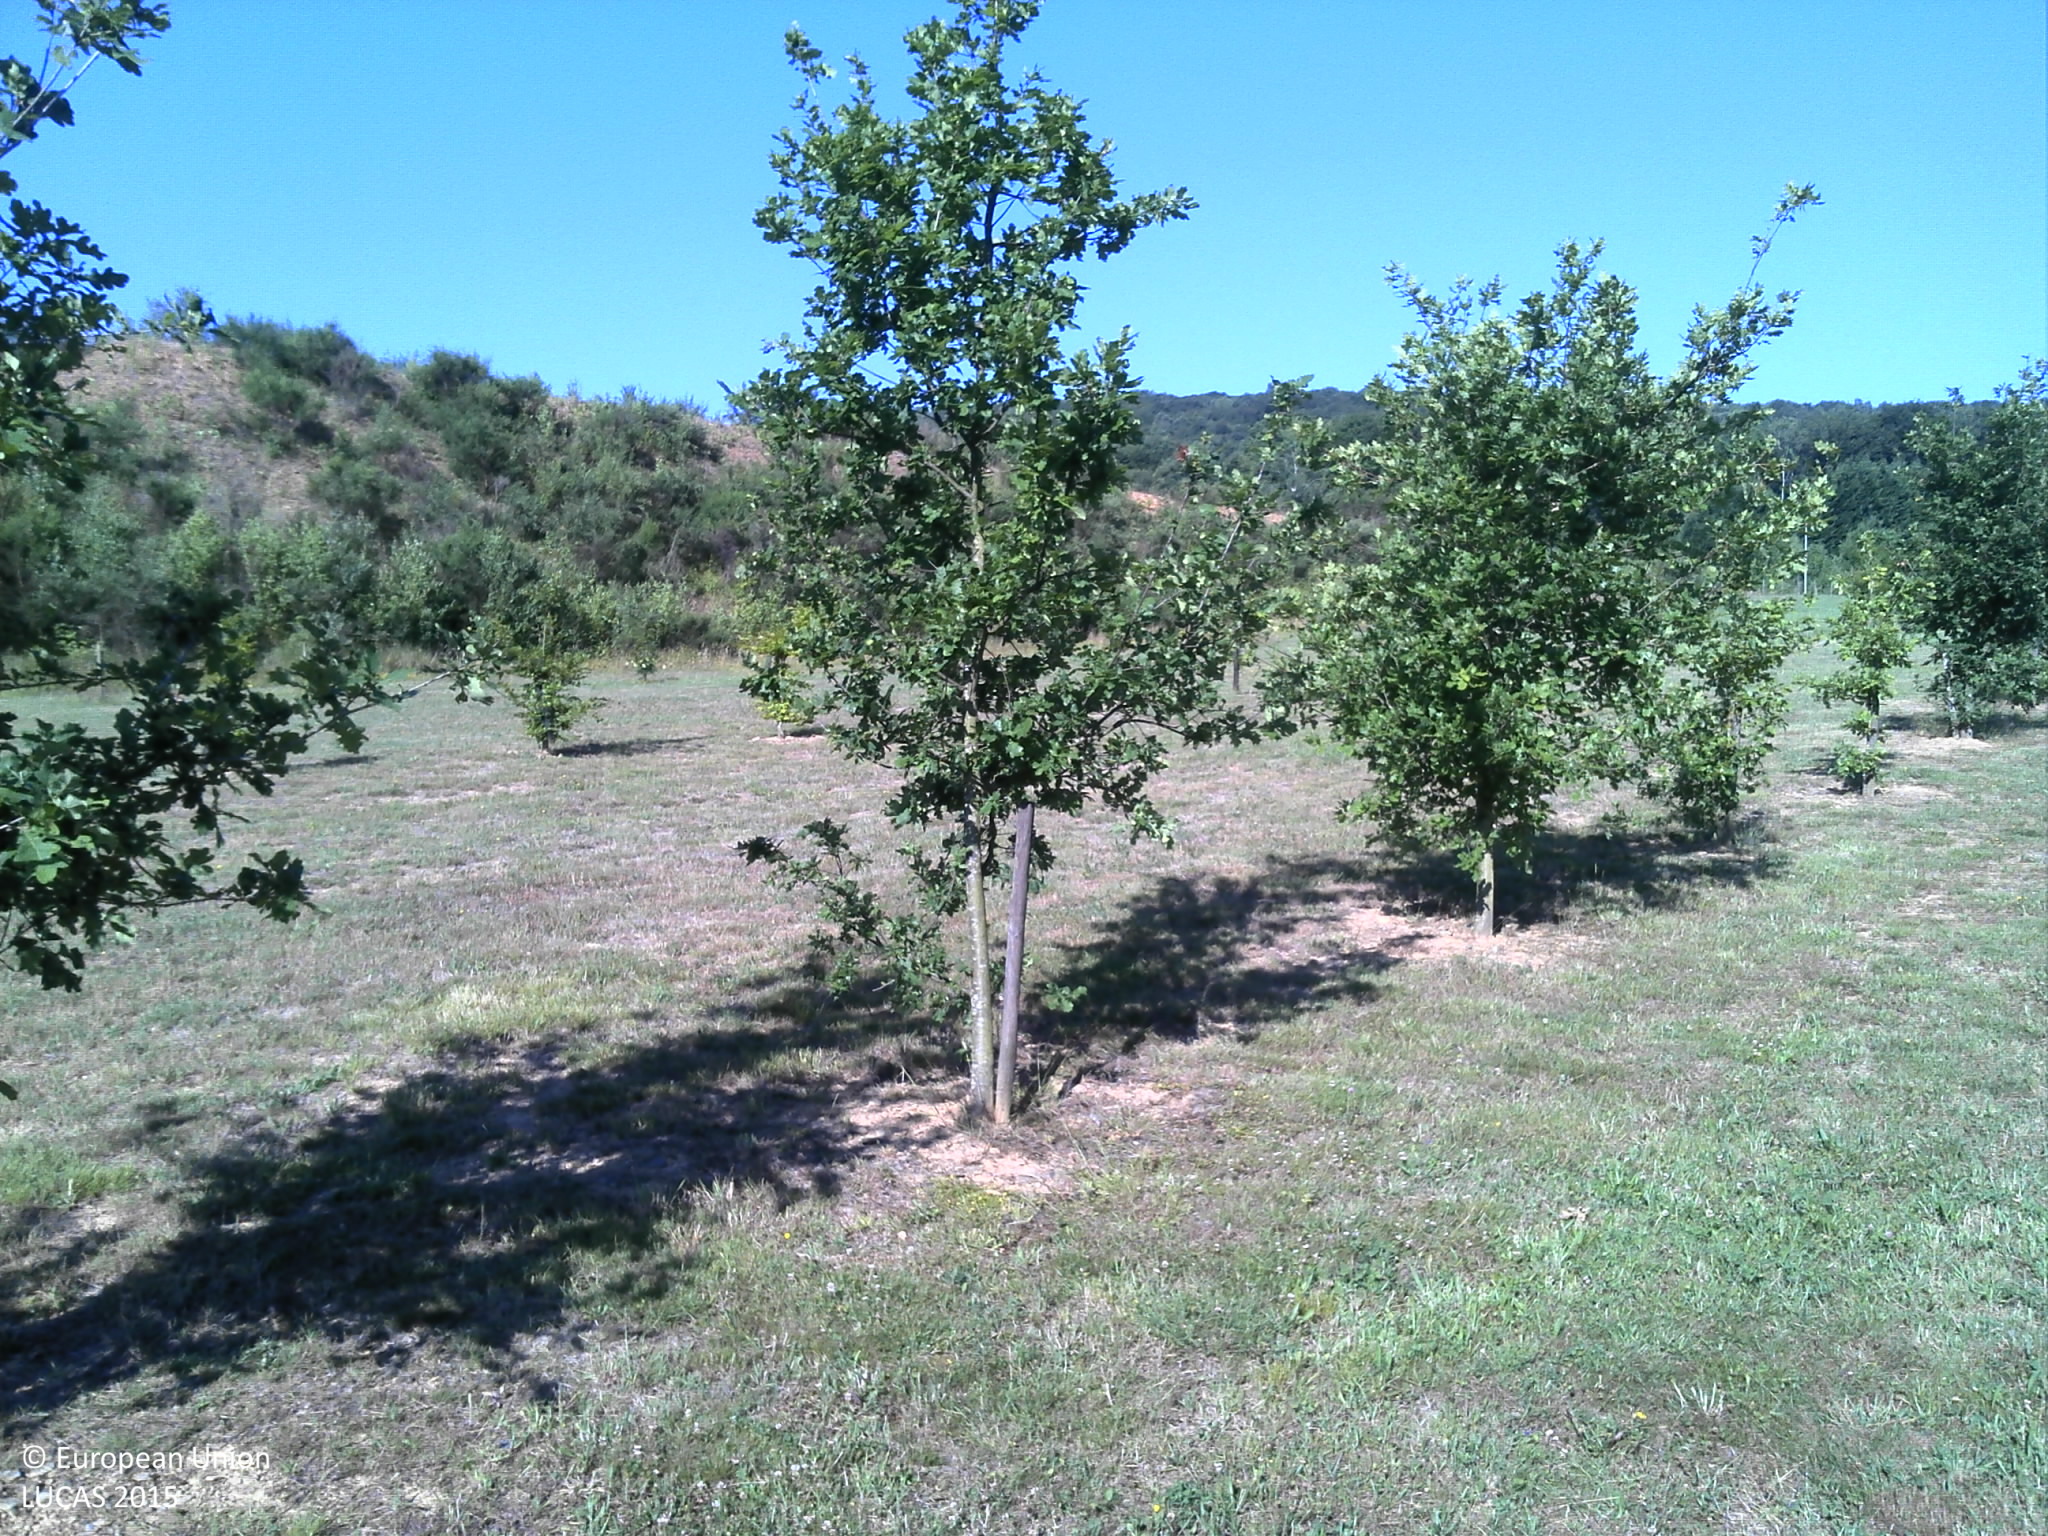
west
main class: Grassland
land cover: Grassland with sparse tree/shrub cover
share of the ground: > 75 %
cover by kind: herbaceous plants 95 %, broadleaved forest trees 5 %
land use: Semi-natural and natural areas not in use
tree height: < 5 m
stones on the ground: > 50 %
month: June
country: FR
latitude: 49.9881
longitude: 4.6824
